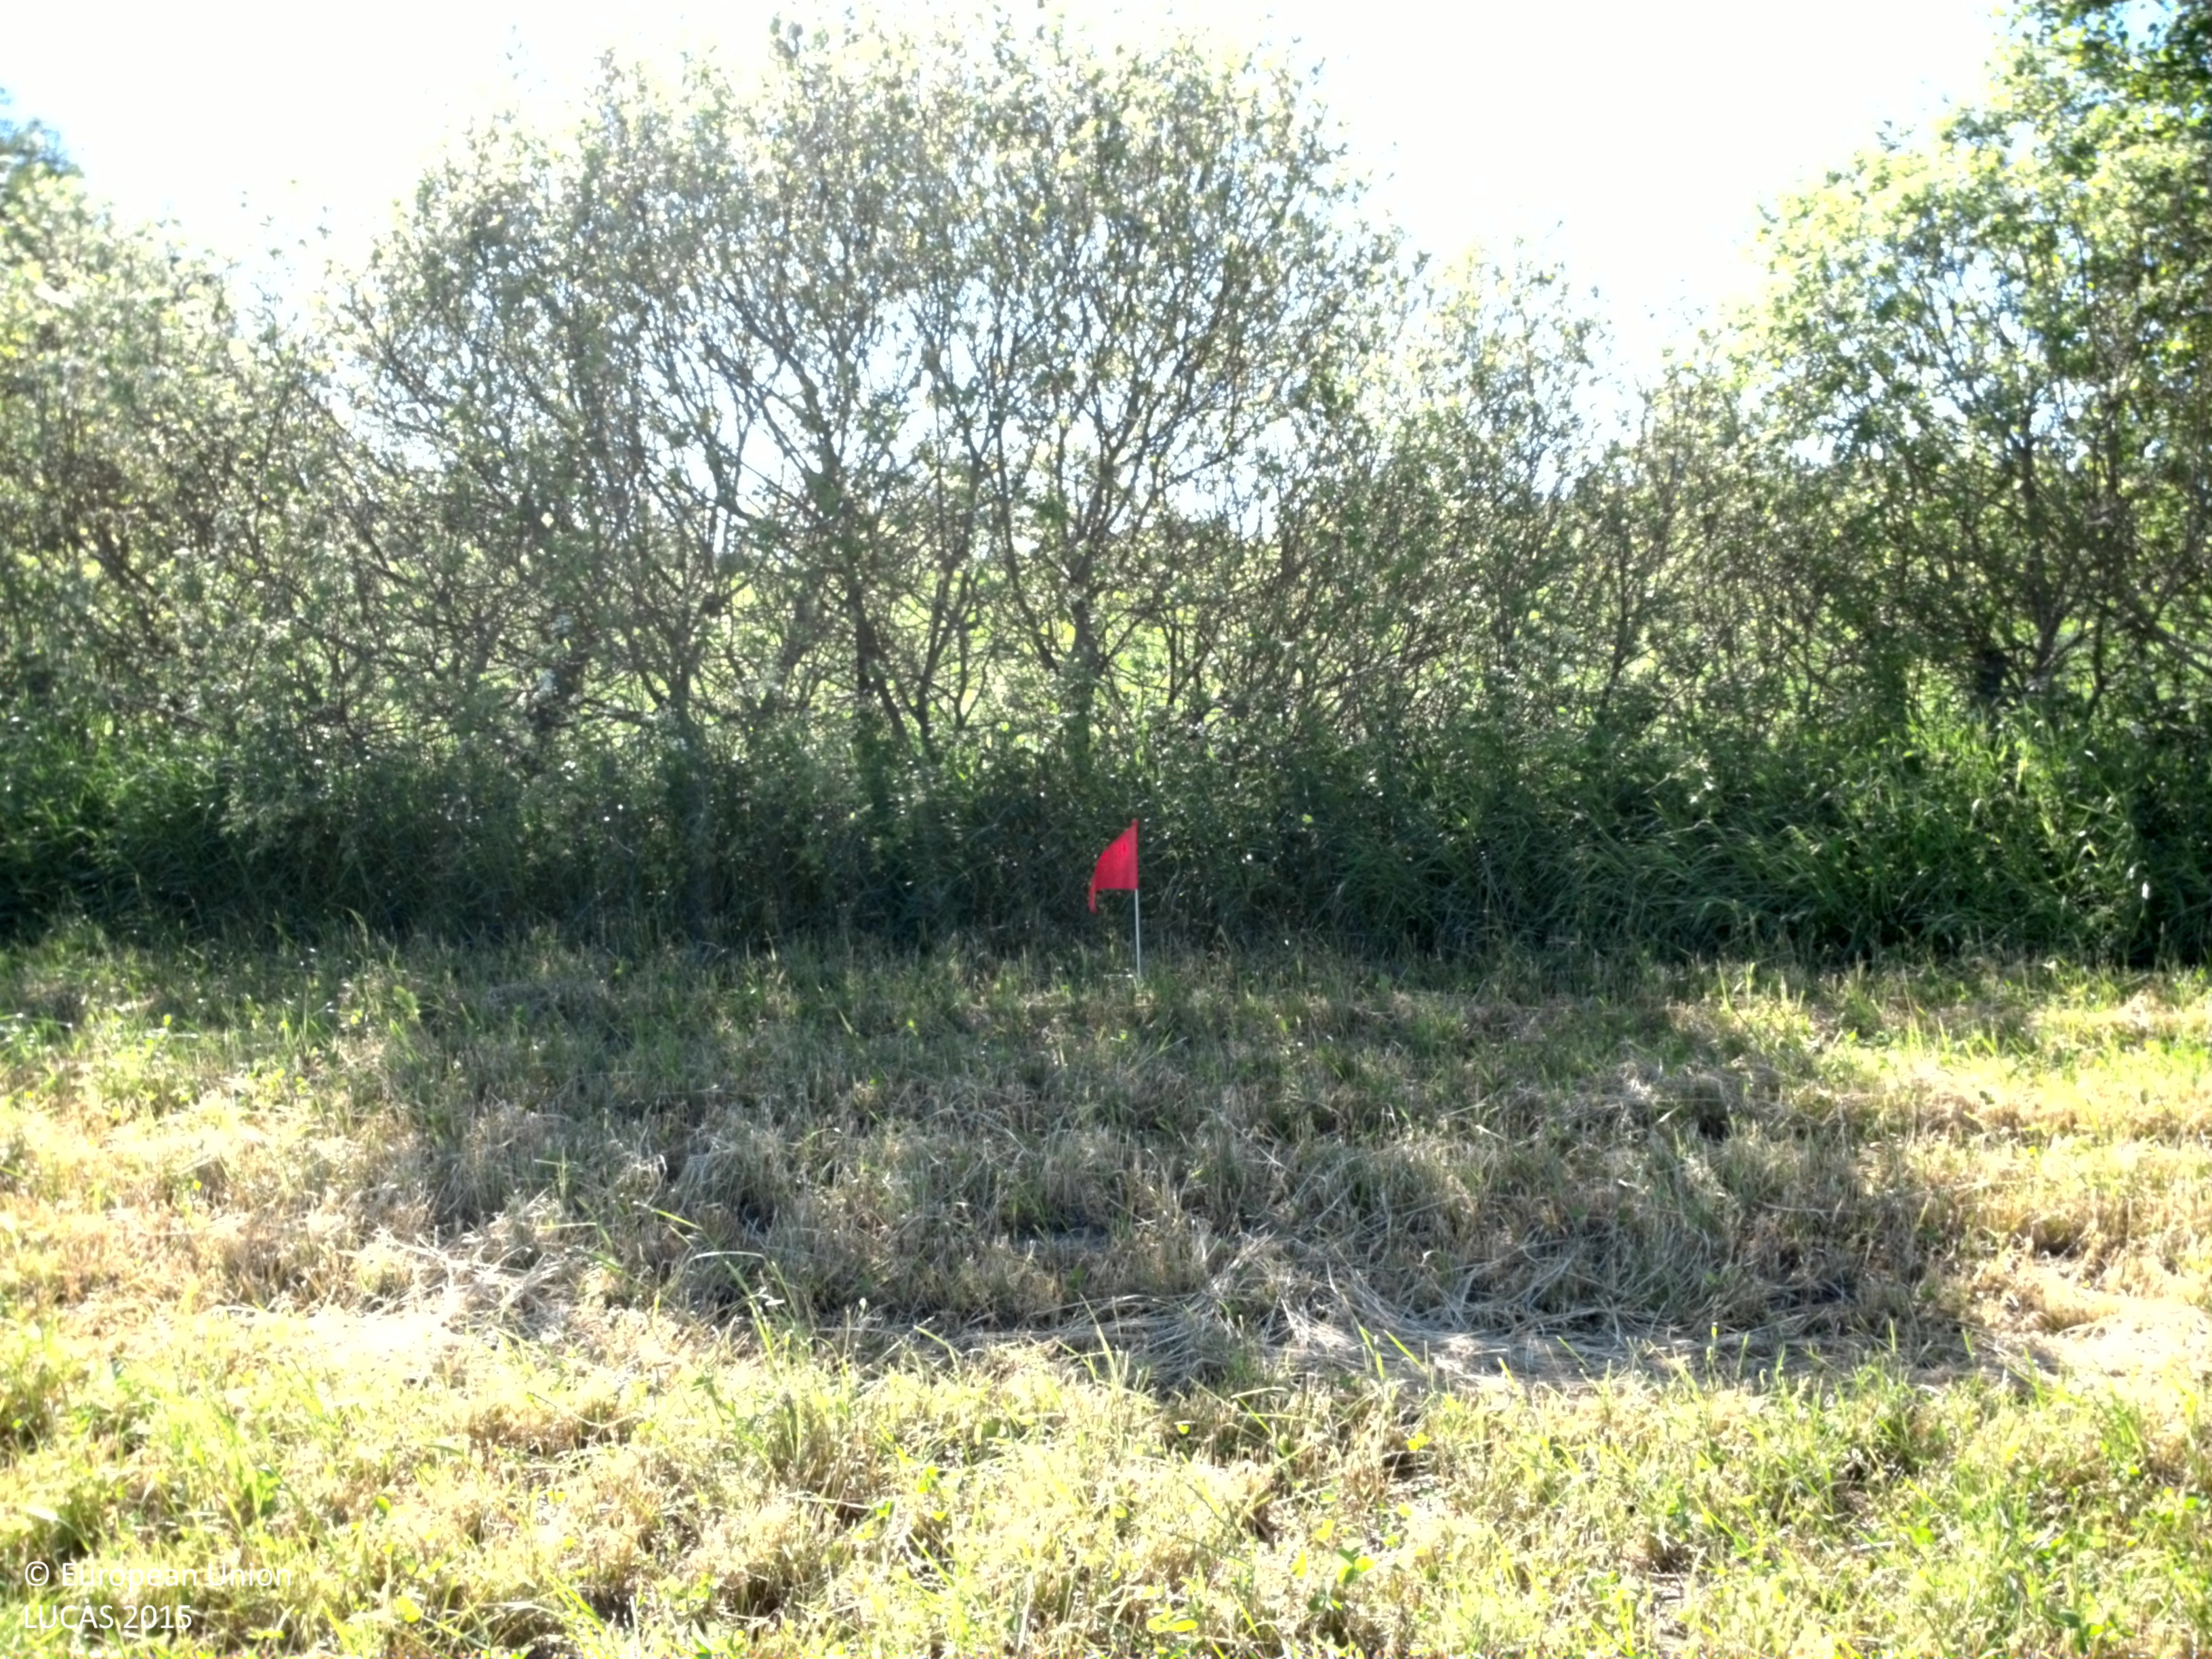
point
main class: Cropland
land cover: Other leguminous and mixtures for fodder
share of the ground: > 75 %
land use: Agriculture (excluding fallow land and kitchen gardens)
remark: Harvested field
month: June
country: SE
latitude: 58.4297
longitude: 14.0181
